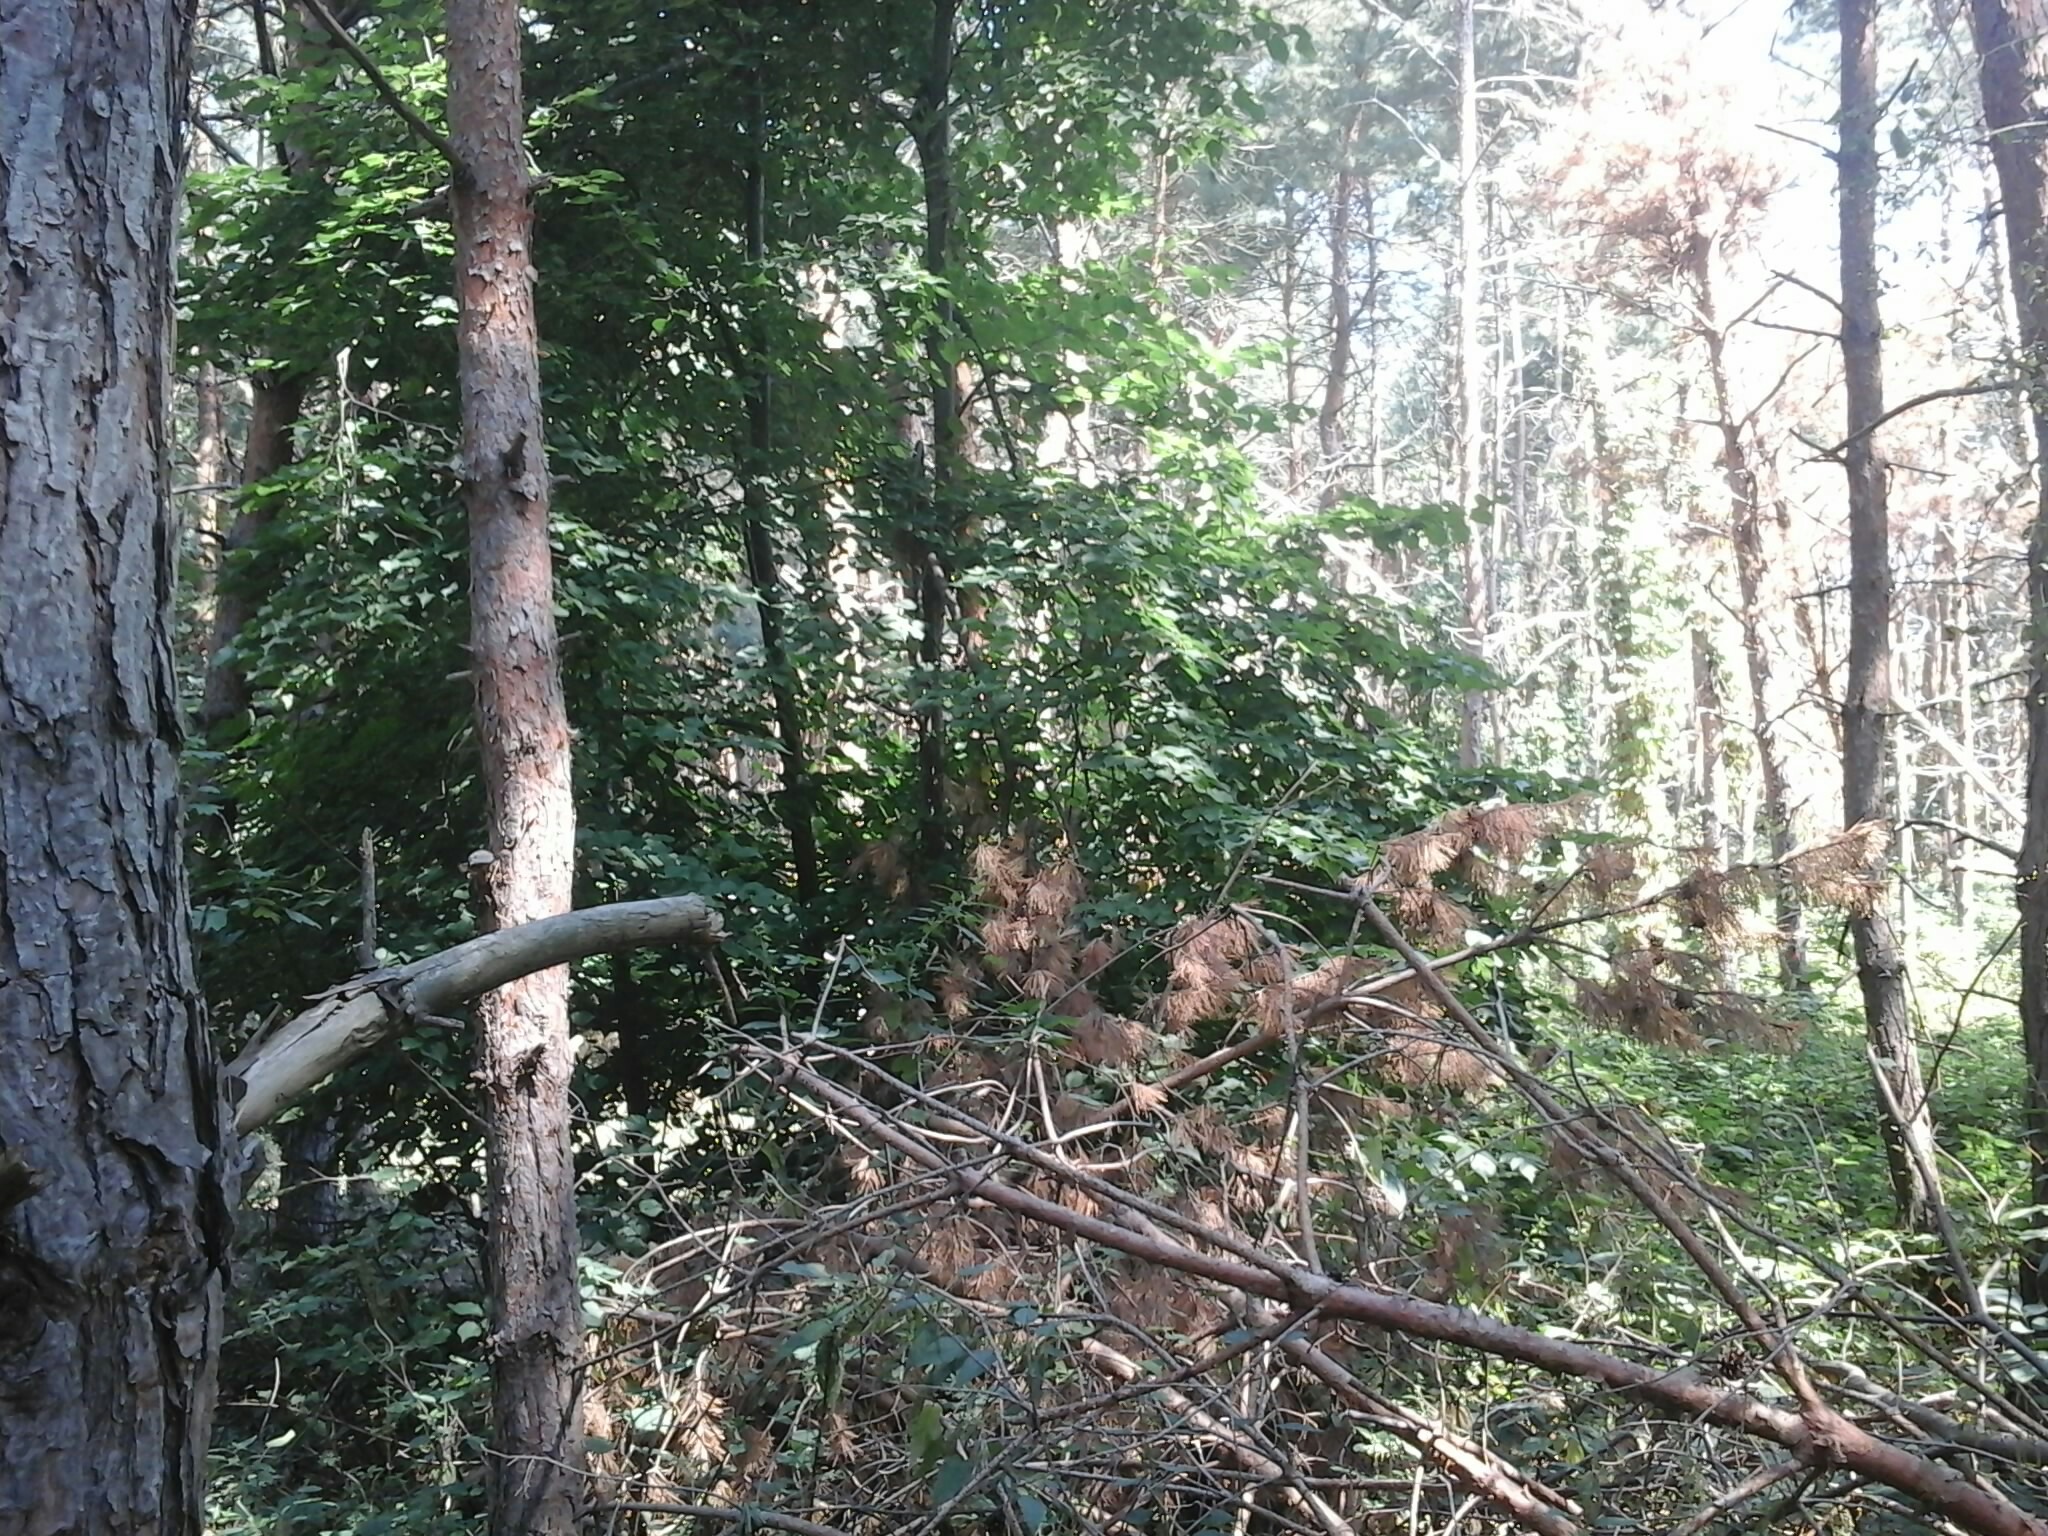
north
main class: Woodland
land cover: Pine dominated coniferous woodland
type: hemiboreal forest and nemoral coniferous forest and mixed broadleaved-coniferous forest
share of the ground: > 75 %
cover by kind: coniferous forest trees 95 %, herbaceous plants 5 %
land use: Forestry
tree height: > 5 m
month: August
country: HU
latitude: 47.4297
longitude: 17.9515
